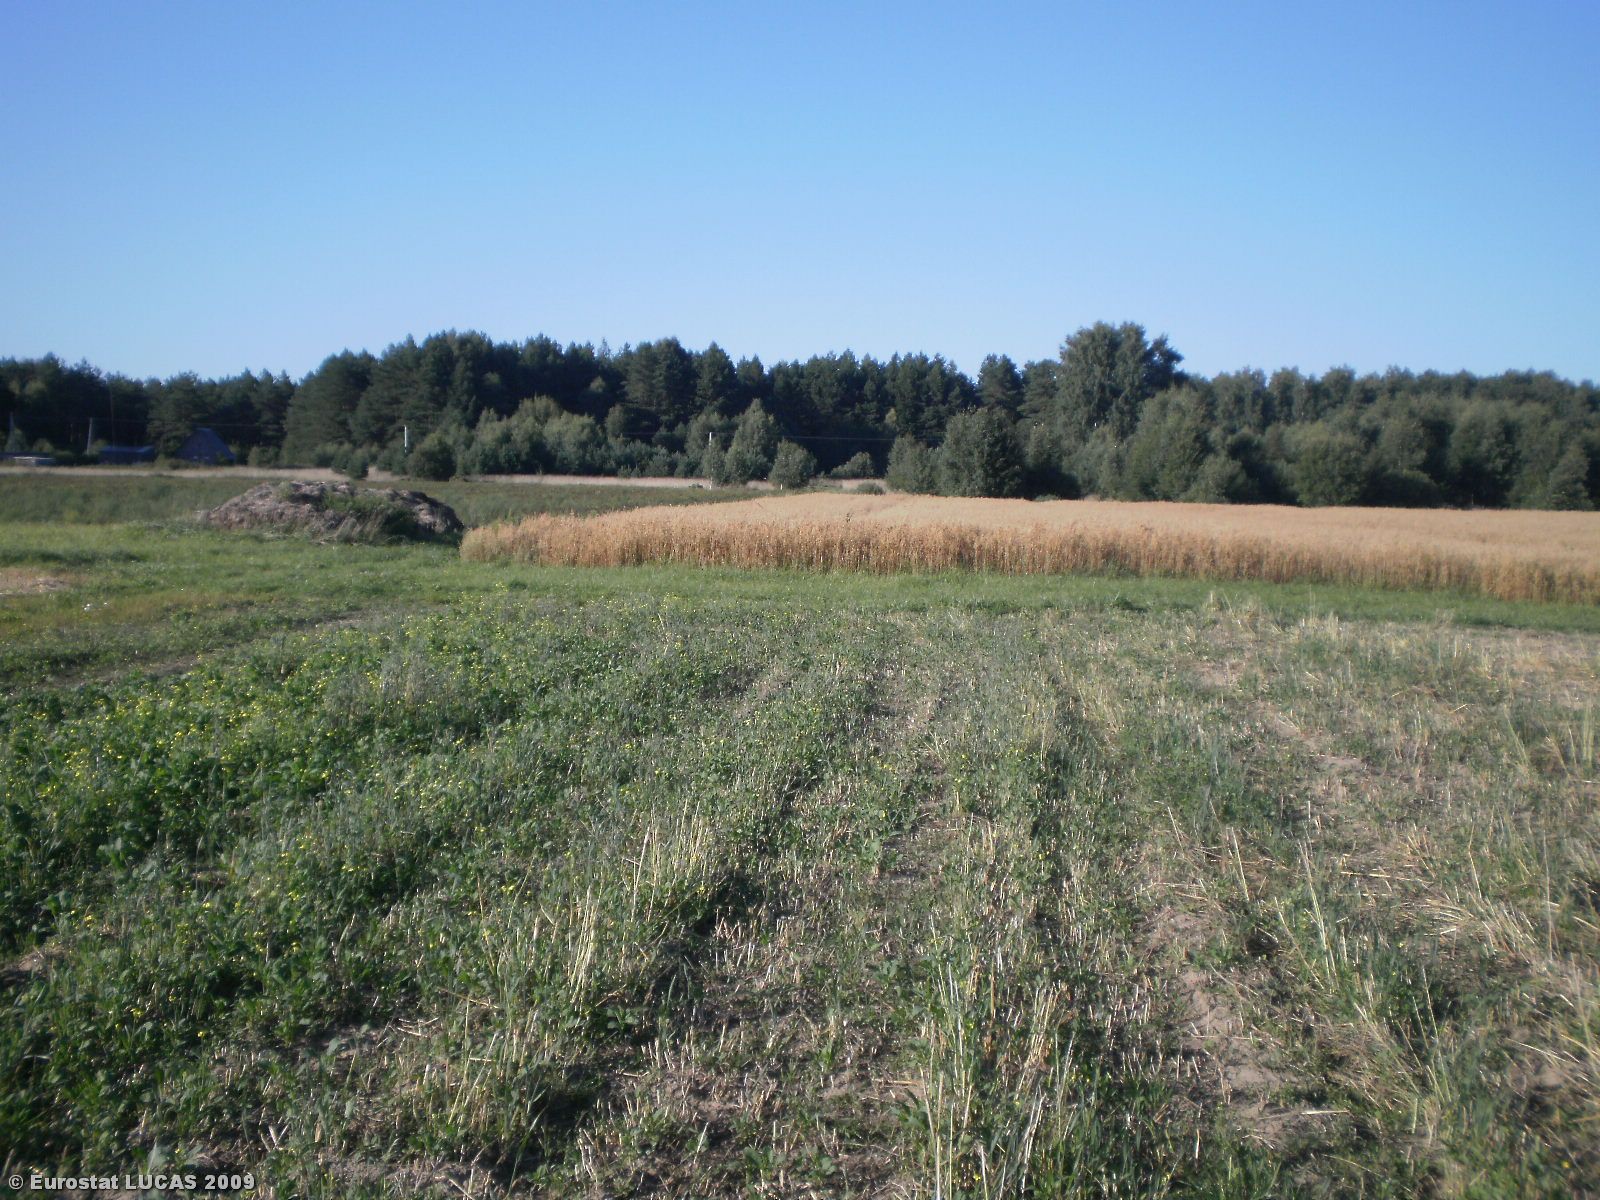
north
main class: Grassland
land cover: Spontaneously vegetated surfaces
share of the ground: > 75 %
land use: Fallow land
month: August
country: LT
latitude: 54.8369
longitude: 24.7275
